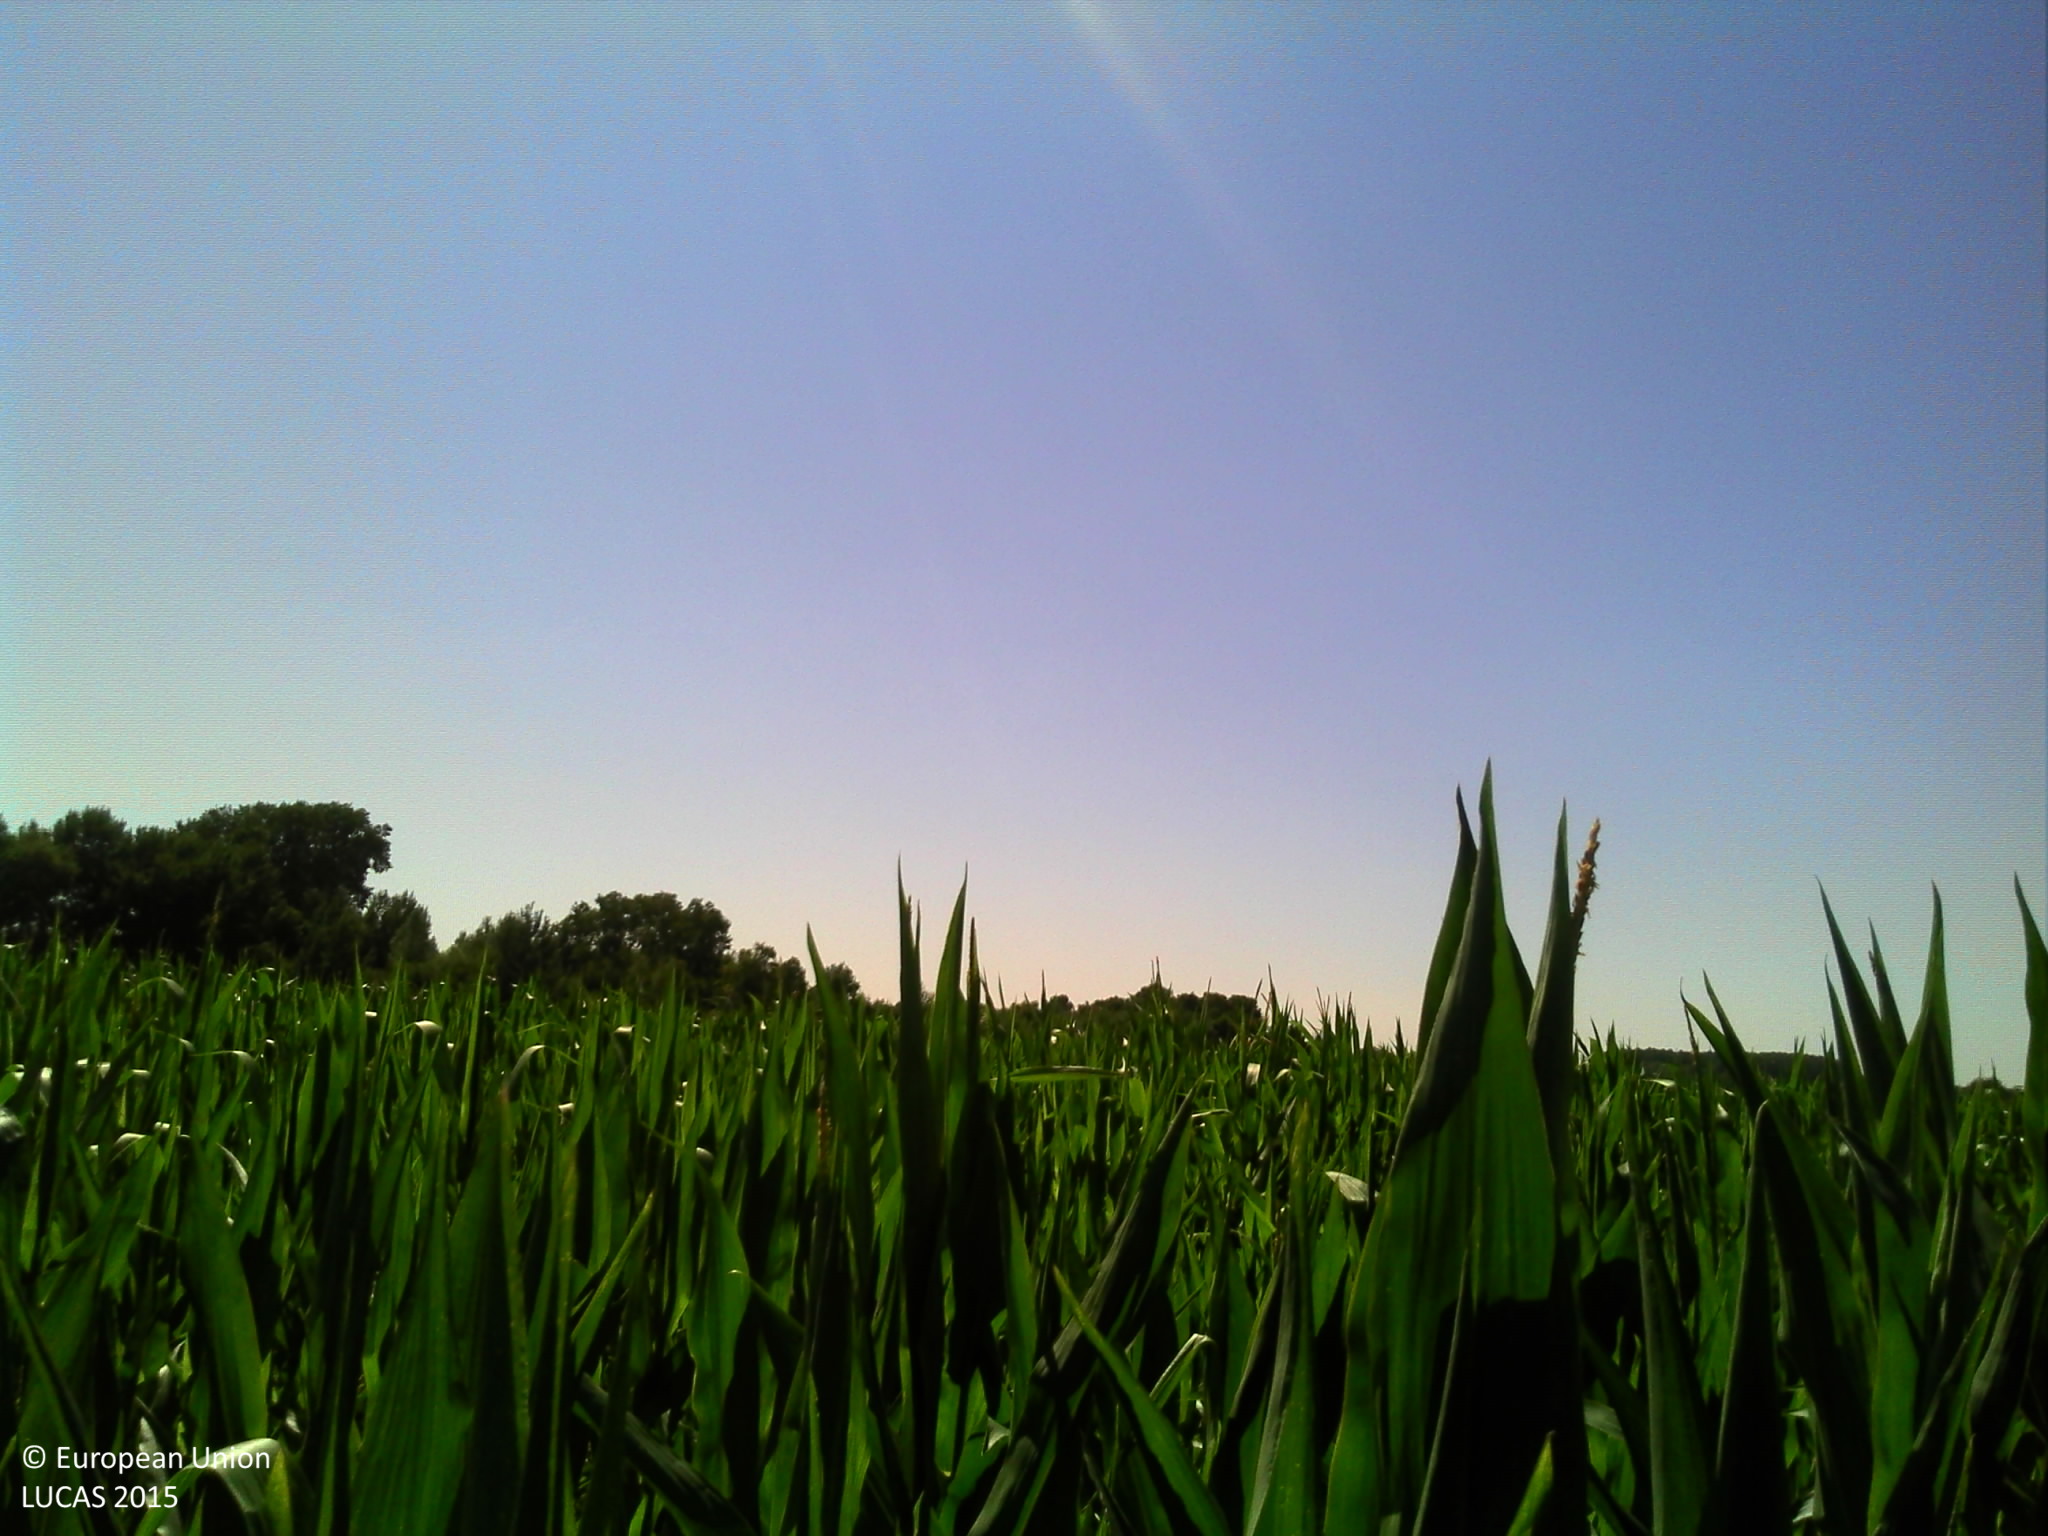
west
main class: Cropland
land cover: Maize
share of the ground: > 75 %
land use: Agriculture (excluding fallow land and kitchen gardens)
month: July
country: FR
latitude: 47.9663
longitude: 2.4765
